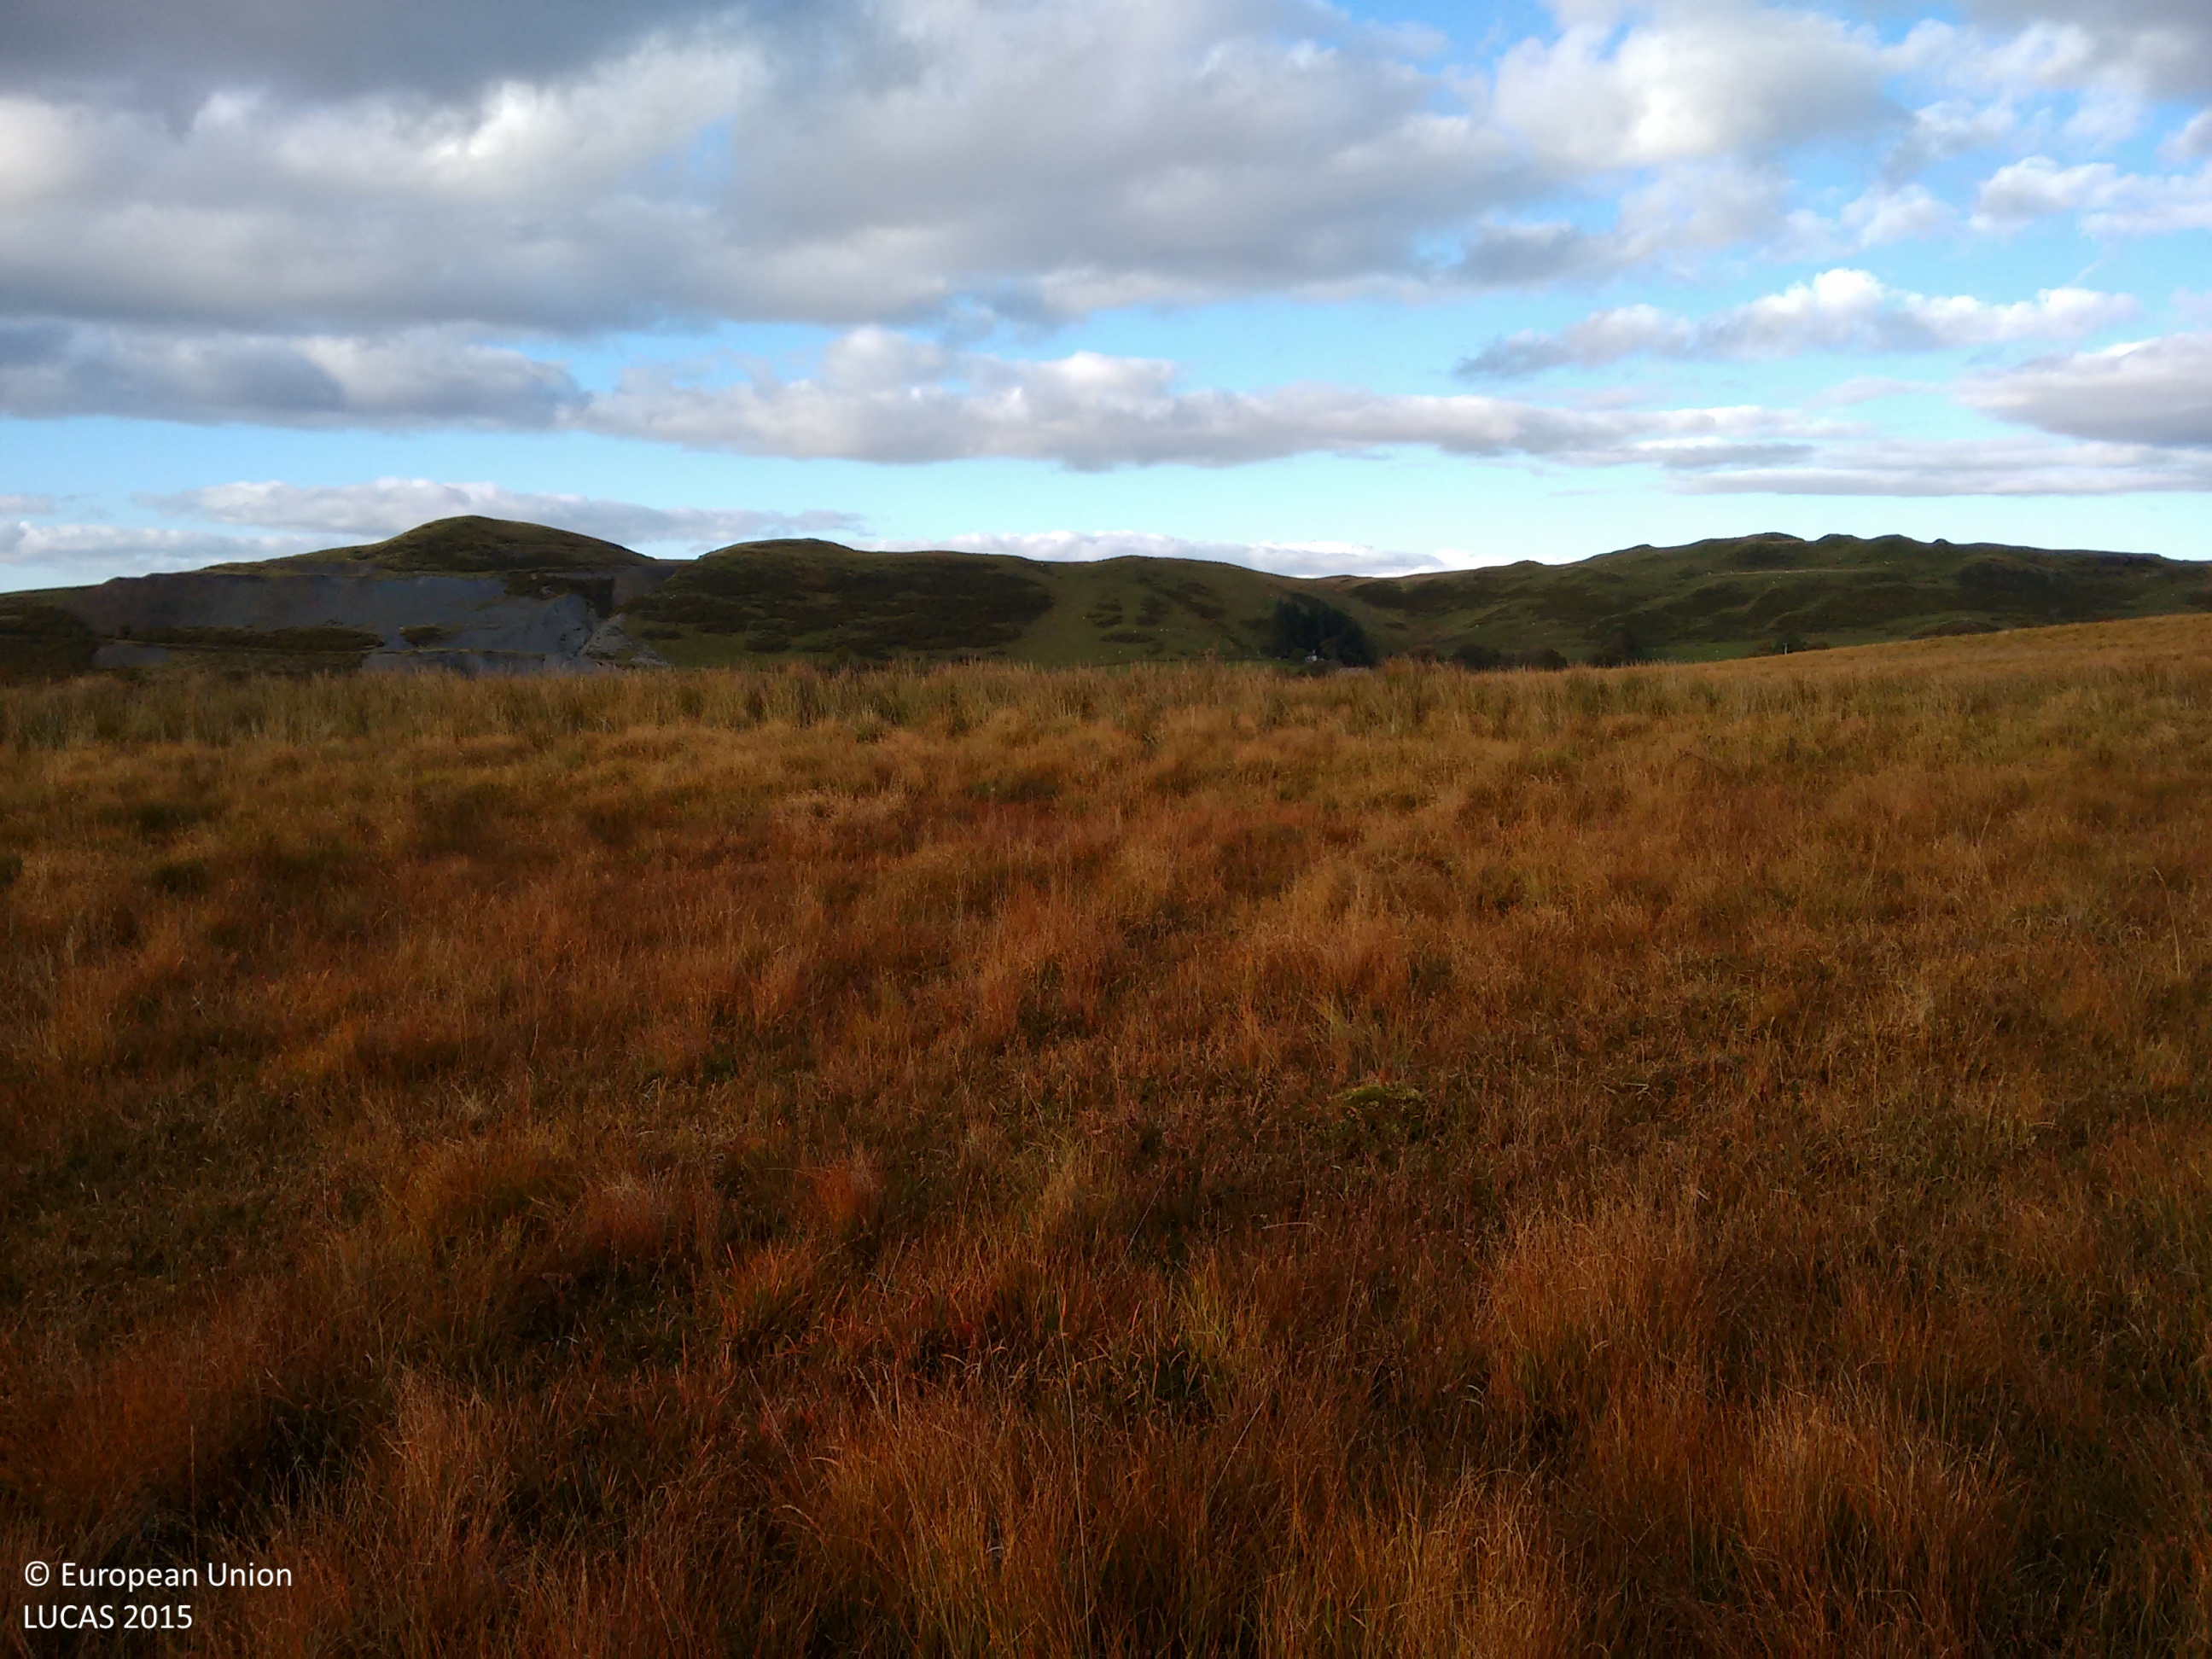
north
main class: Grassland
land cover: Grassland without tree/shrub cover
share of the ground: > 75 %
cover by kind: herbaceous plants 90 %, lichens and mosses 10 %
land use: Agriculture (excluding fallow land and kitchen gardens)
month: October
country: GB
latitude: 52.3105
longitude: -3.8348
